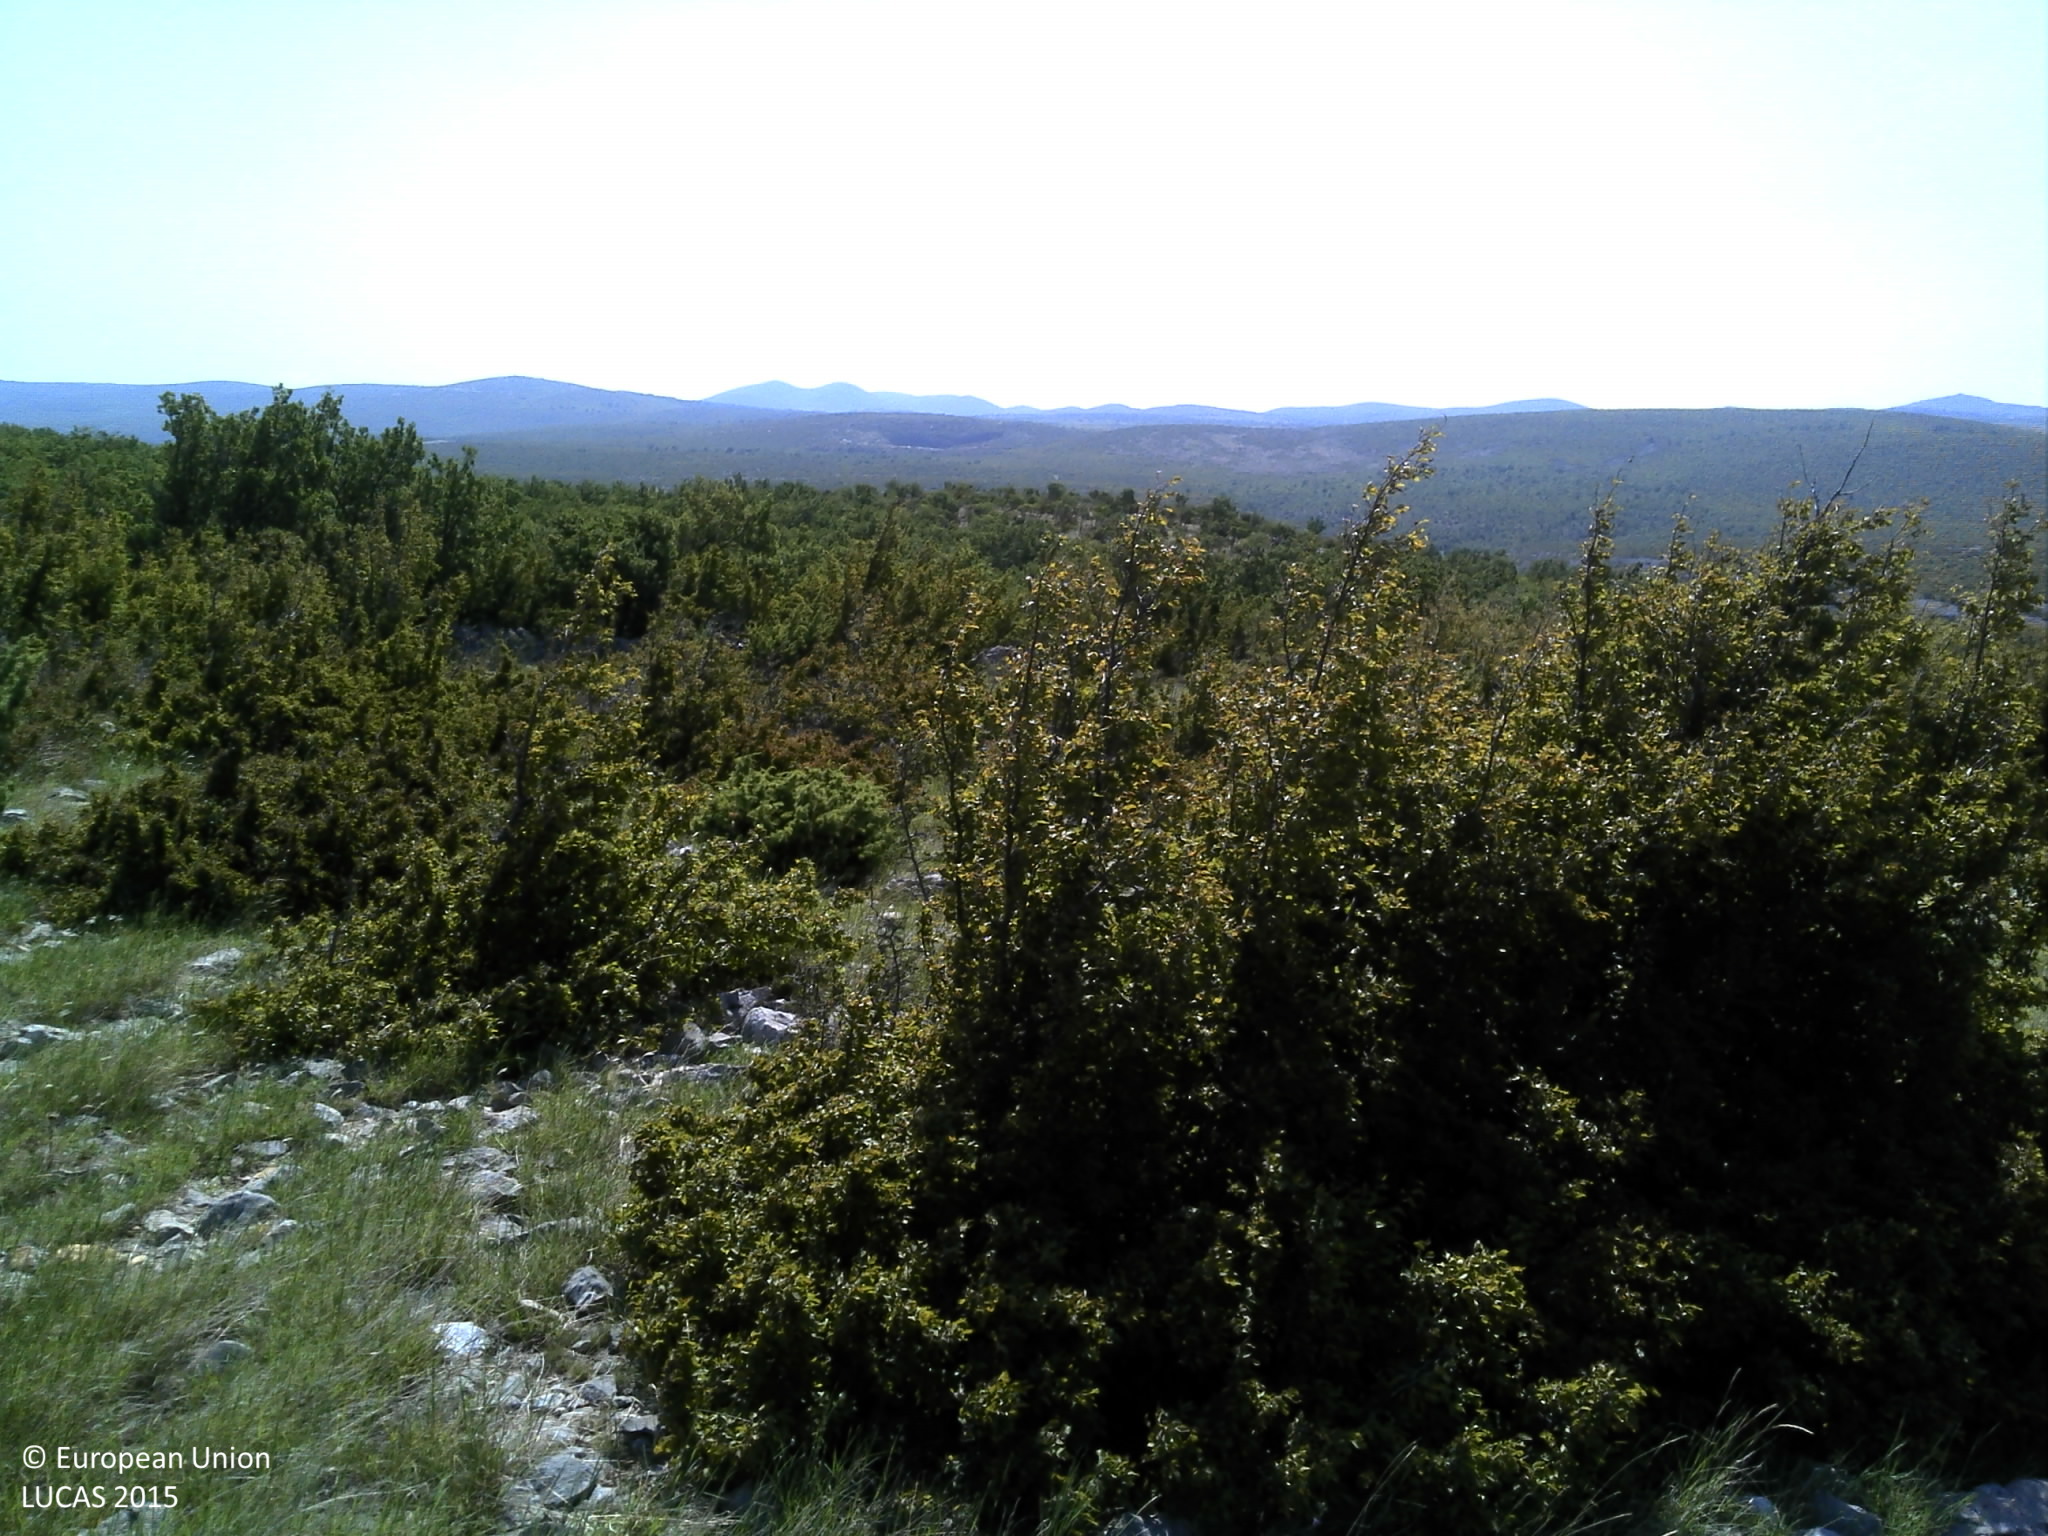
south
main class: Shrubland
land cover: Shrubland with sparse tree cover
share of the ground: > 75 %
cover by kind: shrubs 50 %, unconsolidated bare surface 25 %, herbaceous plants 20 %, broadleaved forest trees 5 %
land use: Semi-natural and natural areas not in use
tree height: < 5 m
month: August
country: HR
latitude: 44.2113
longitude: 15.7121
